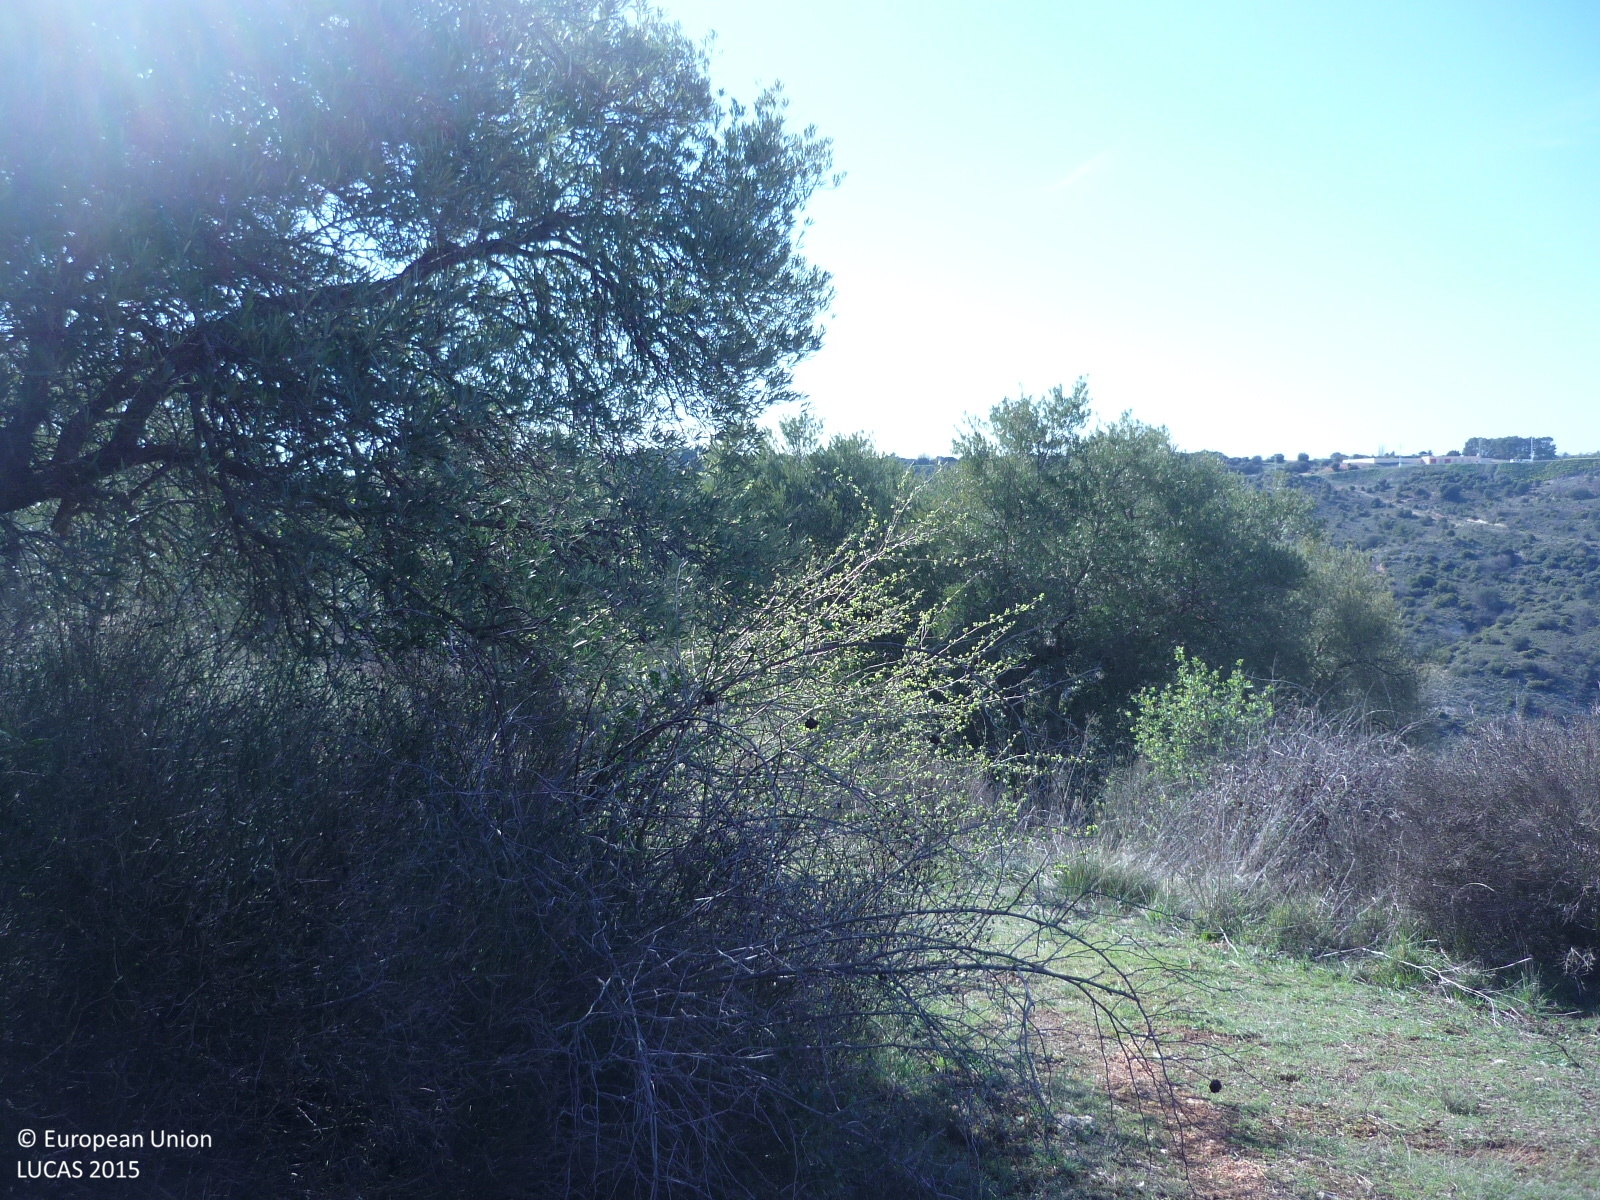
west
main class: Cropland
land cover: Olive groves
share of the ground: 25 - 50 %
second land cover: Other bare soil
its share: > 75 %
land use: Agriculture (excluding fallow land and kitchen gardens)
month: March
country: ES
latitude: 40.3555
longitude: -3.2300
